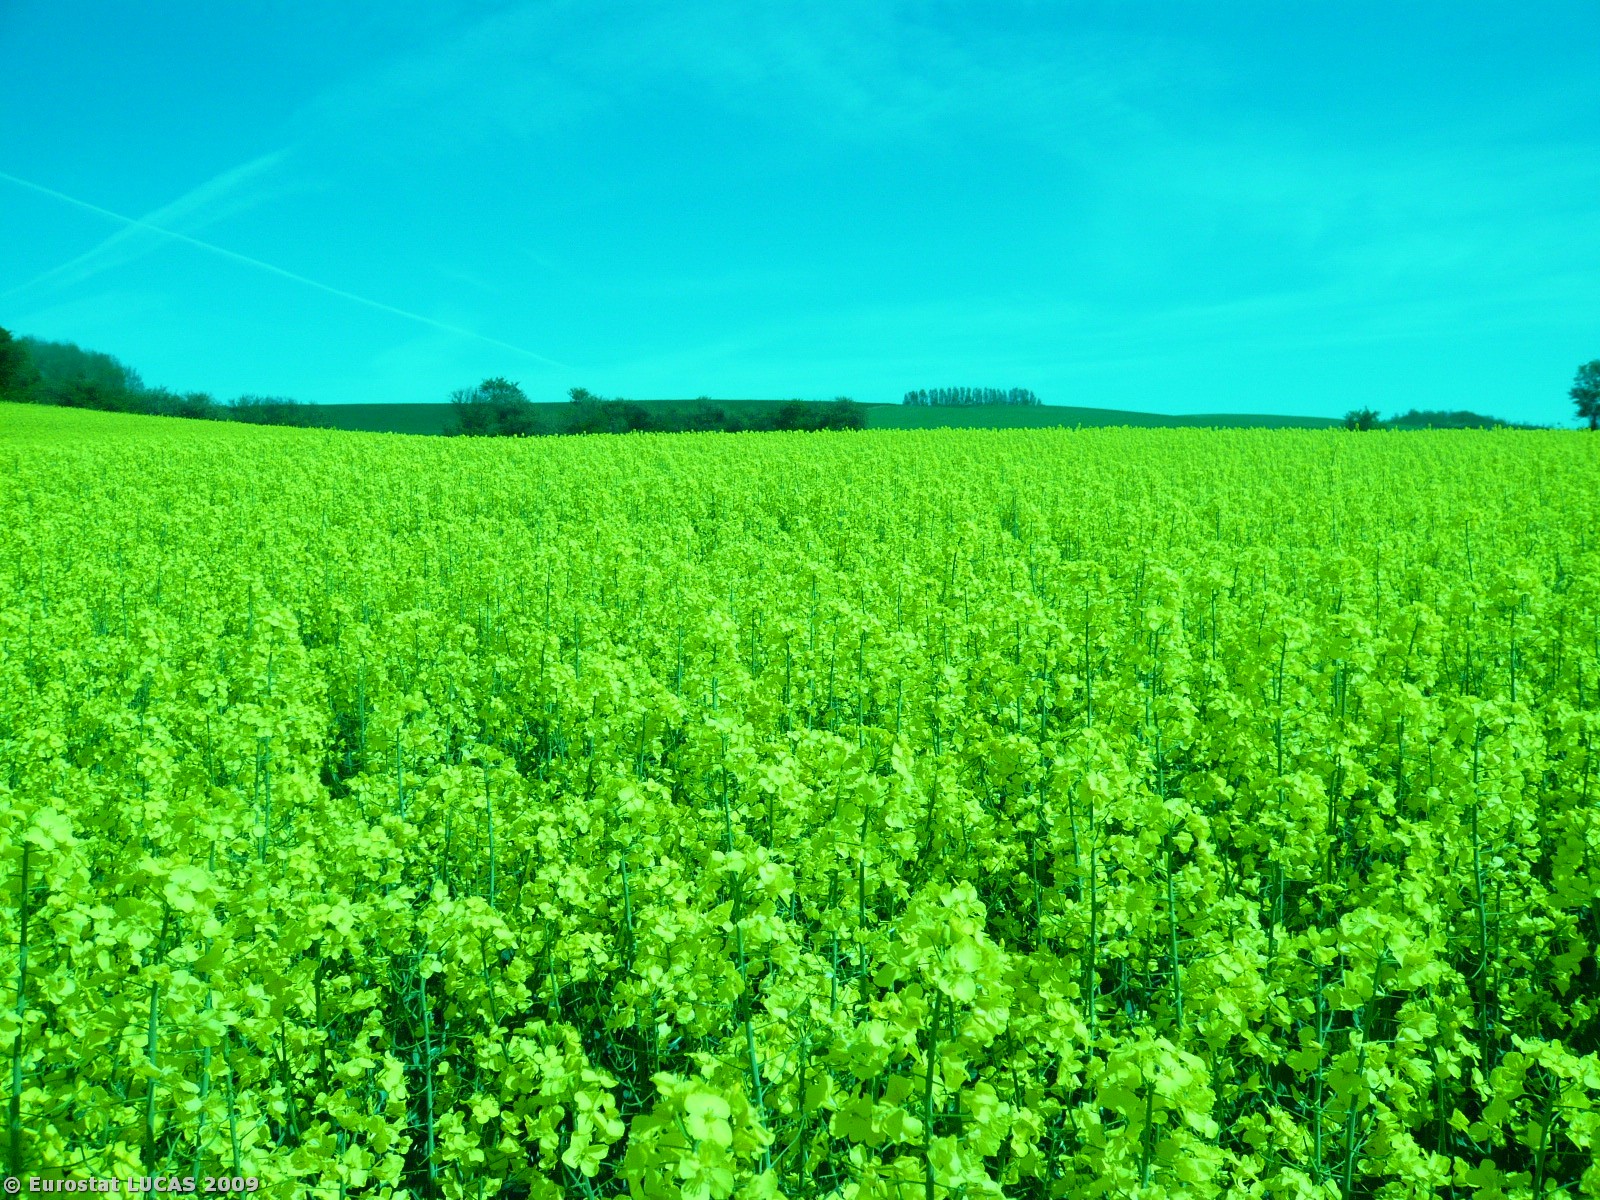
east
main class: Cropland
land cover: Rape and turnip rape
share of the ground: > 75 %
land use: Agriculture (excluding fallow land and kitchen gardens)
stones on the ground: < 10 %
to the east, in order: Rape and turnip rape; Broadleaved woodland; Barley
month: May
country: DK
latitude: 55.0037
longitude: 11.9842
